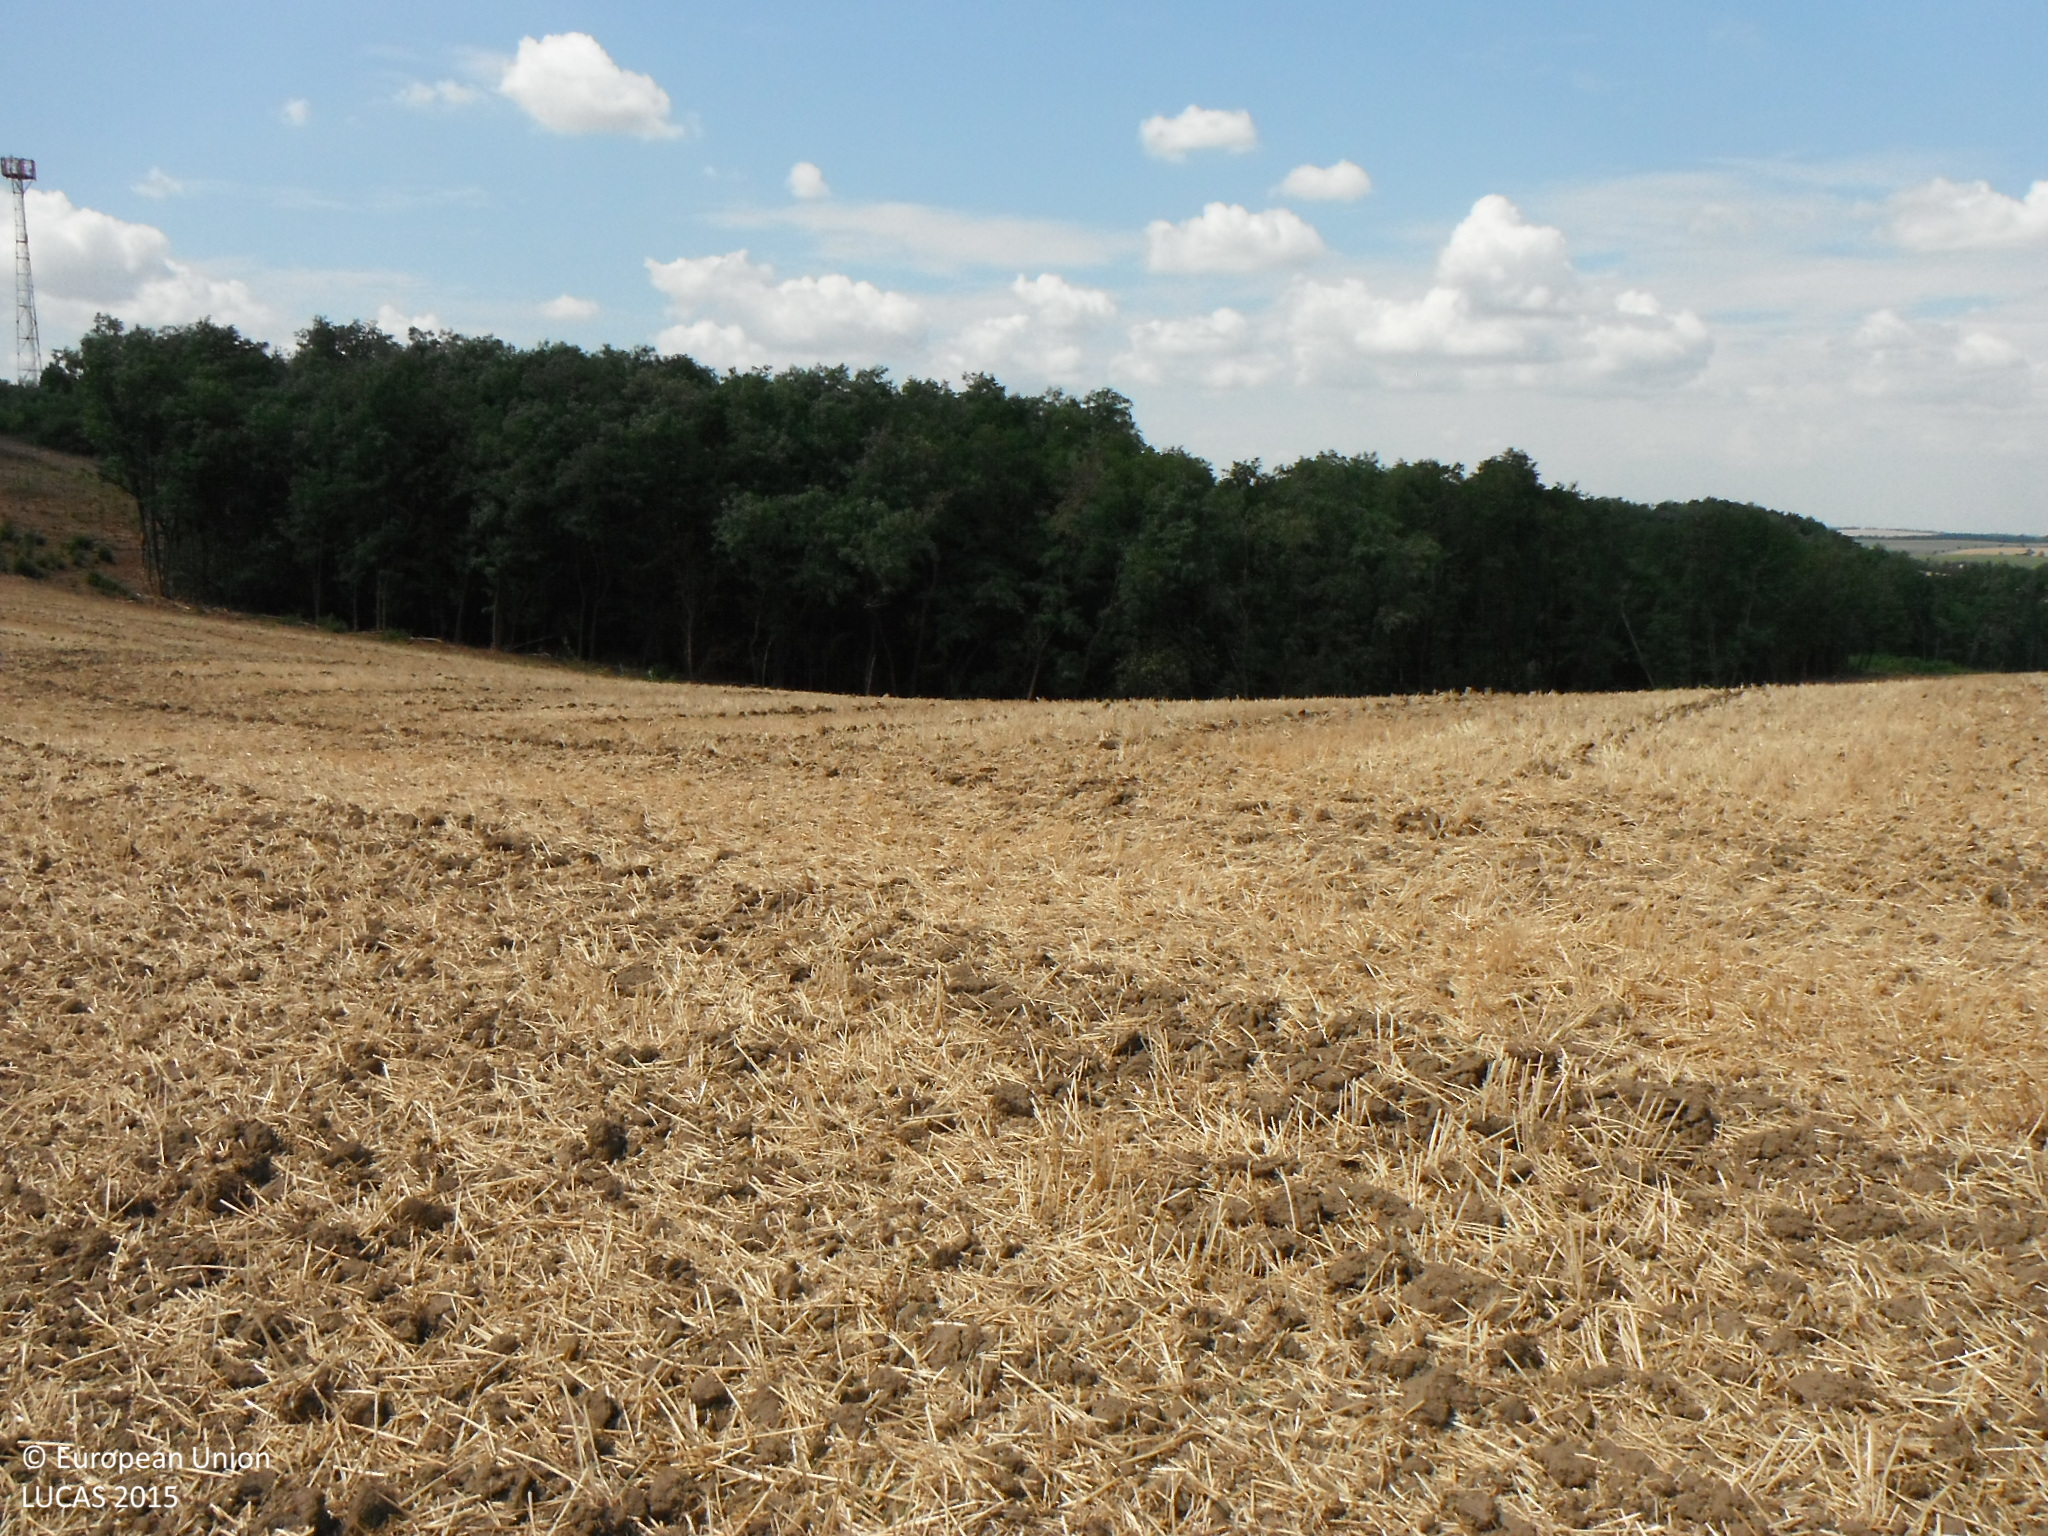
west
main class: Cropland
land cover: Common wheat
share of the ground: 10 - 25 %
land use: Agriculture (excluding fallow land and kitchen gardens)
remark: Harvested field
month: August
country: SK
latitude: 48.1346
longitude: 18.4408
